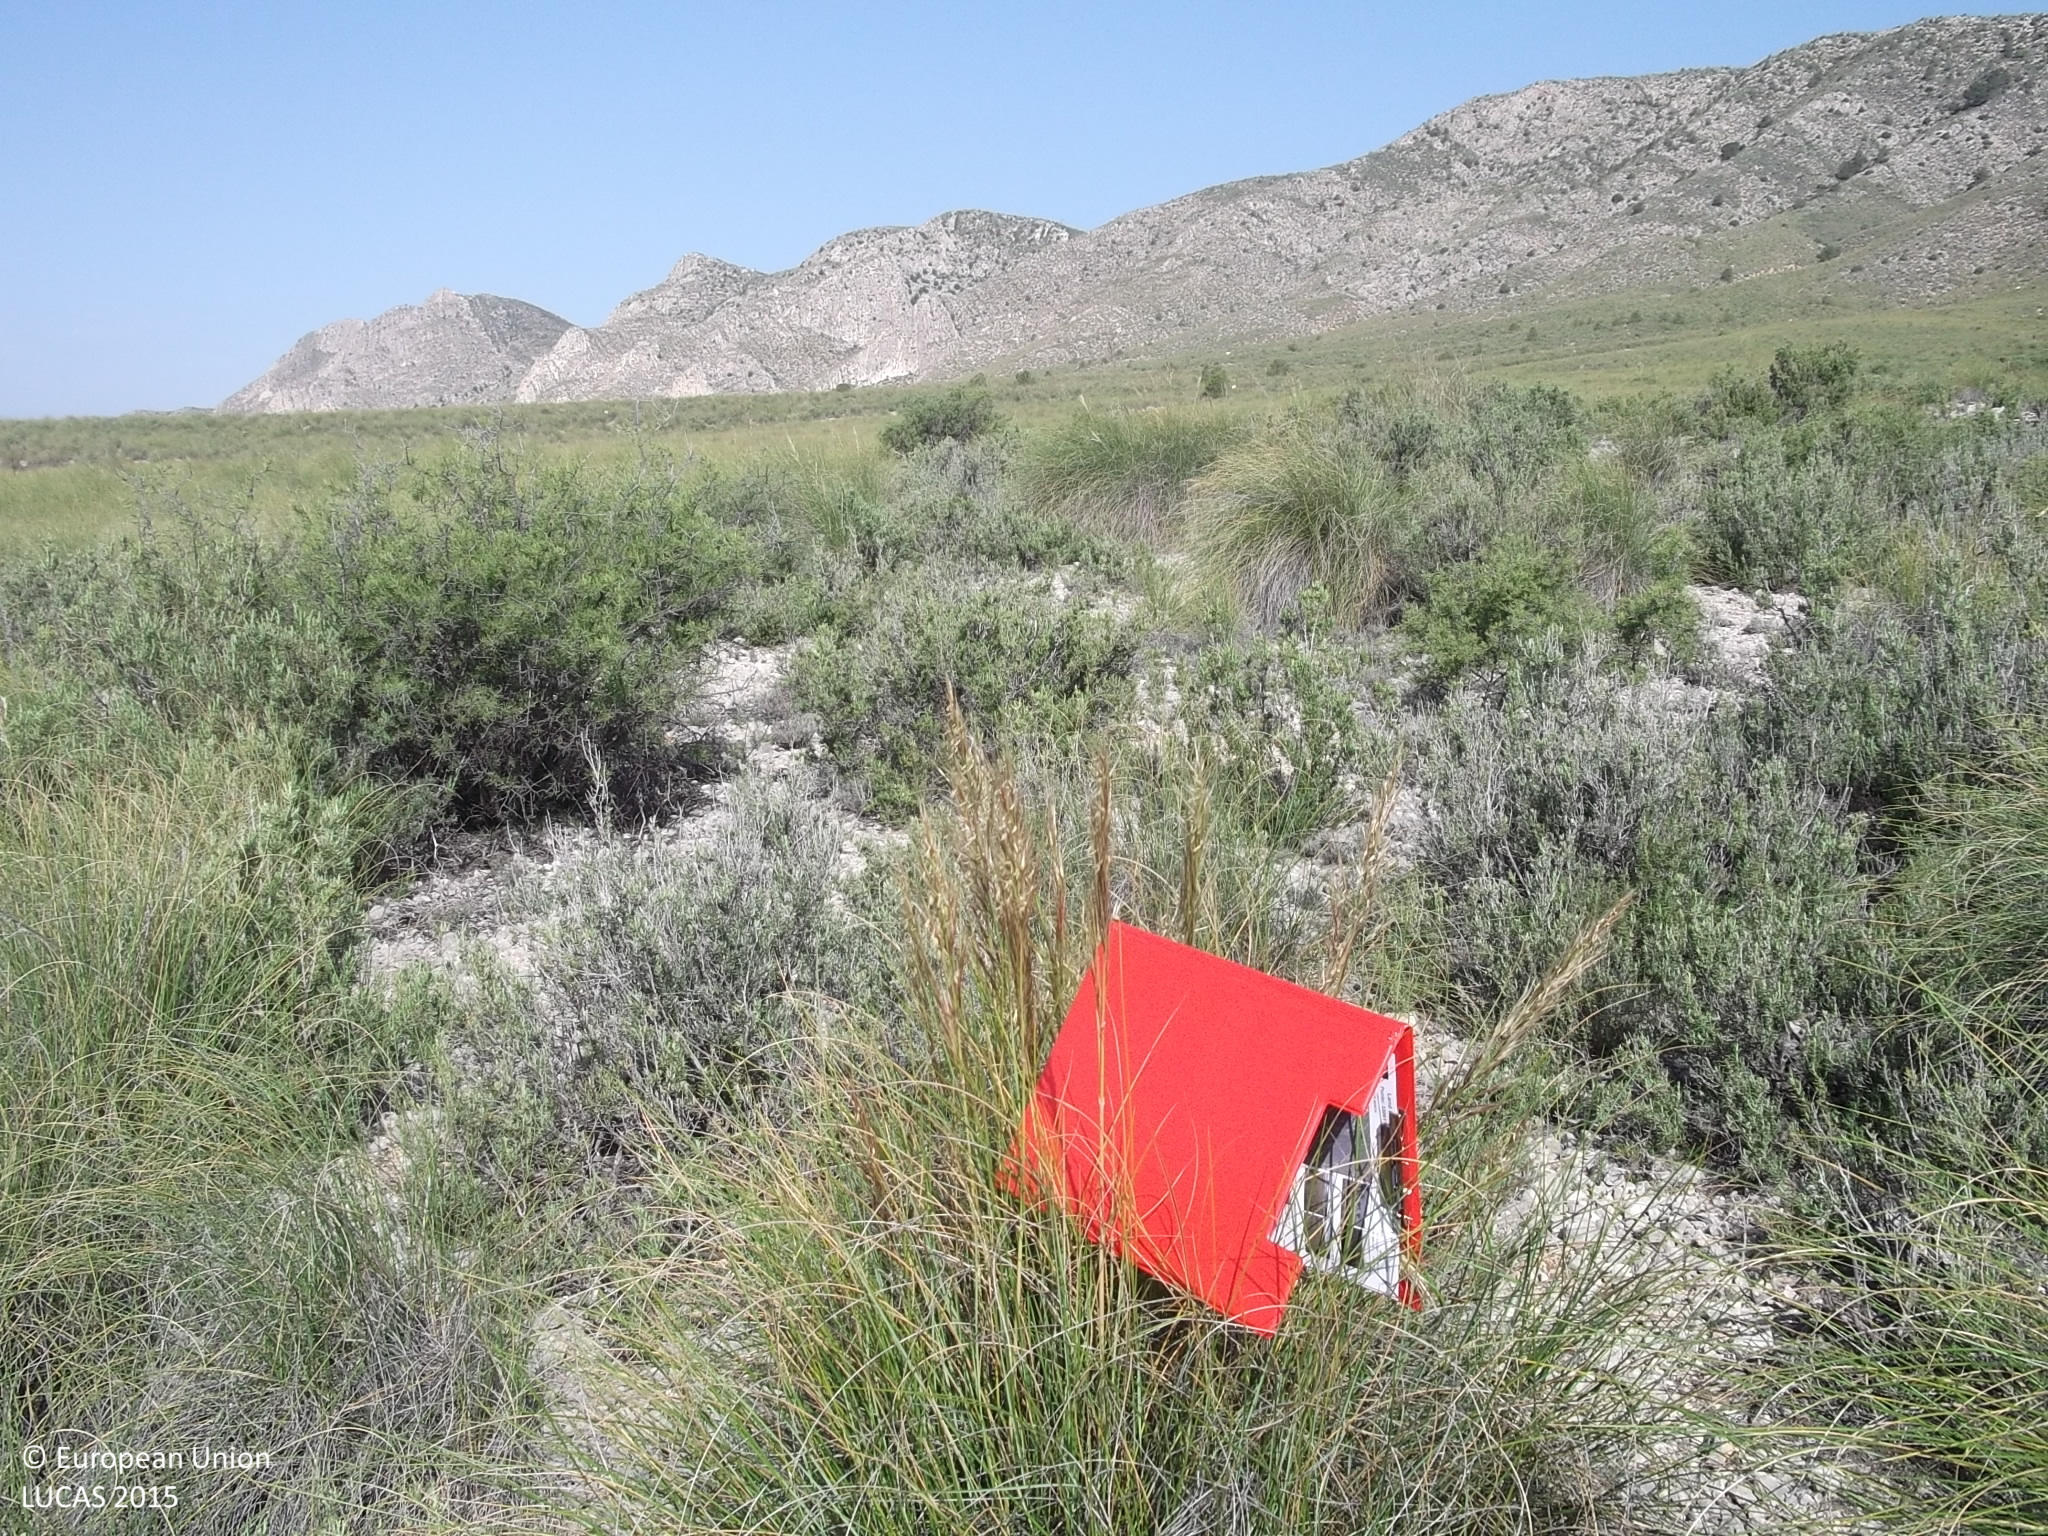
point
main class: Shrubland
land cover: Shrubland without tree cover
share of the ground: 50 - 75 %
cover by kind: consolidated bare surface 60 %, shrubs 40 %
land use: Abandoned areas
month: April
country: ES
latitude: 38.3008
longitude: -1.5735
